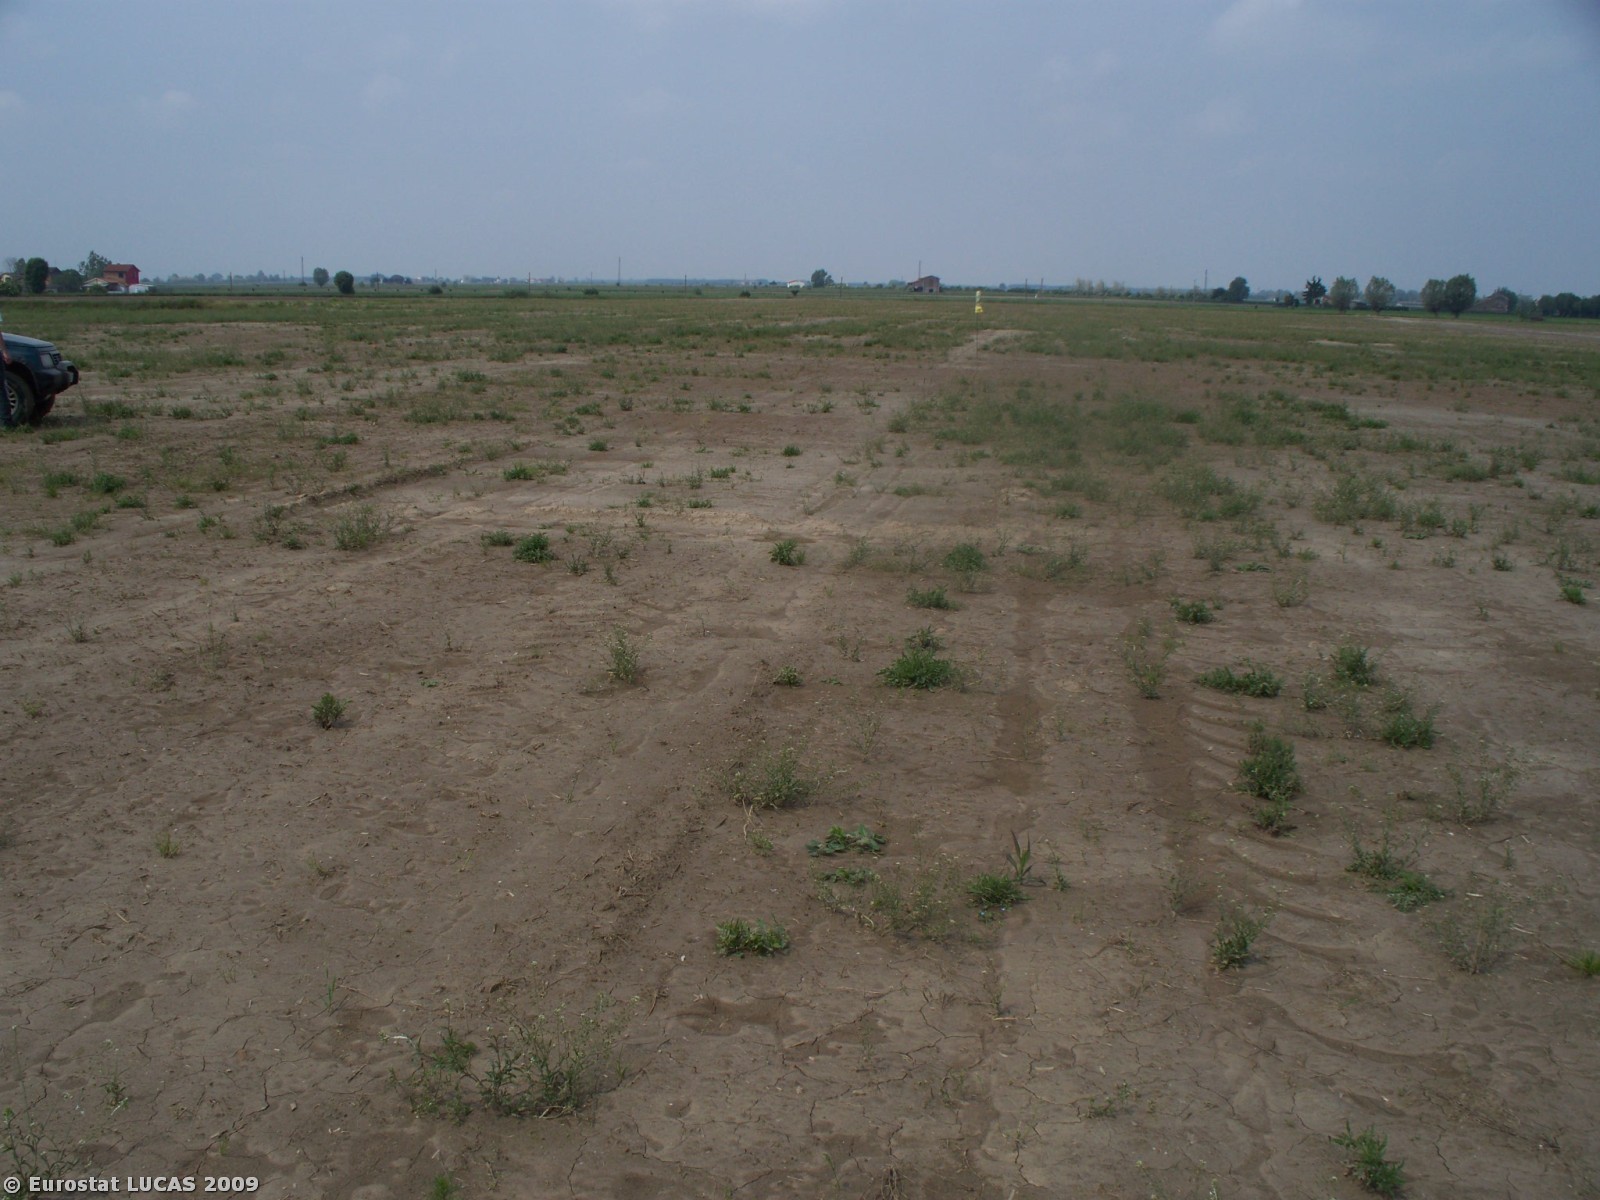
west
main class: Grassland
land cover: Spontaneously vegetated surfaces
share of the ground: > 75 %
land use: Fallow land
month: May
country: IT
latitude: 45.1236
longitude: 12.0686
